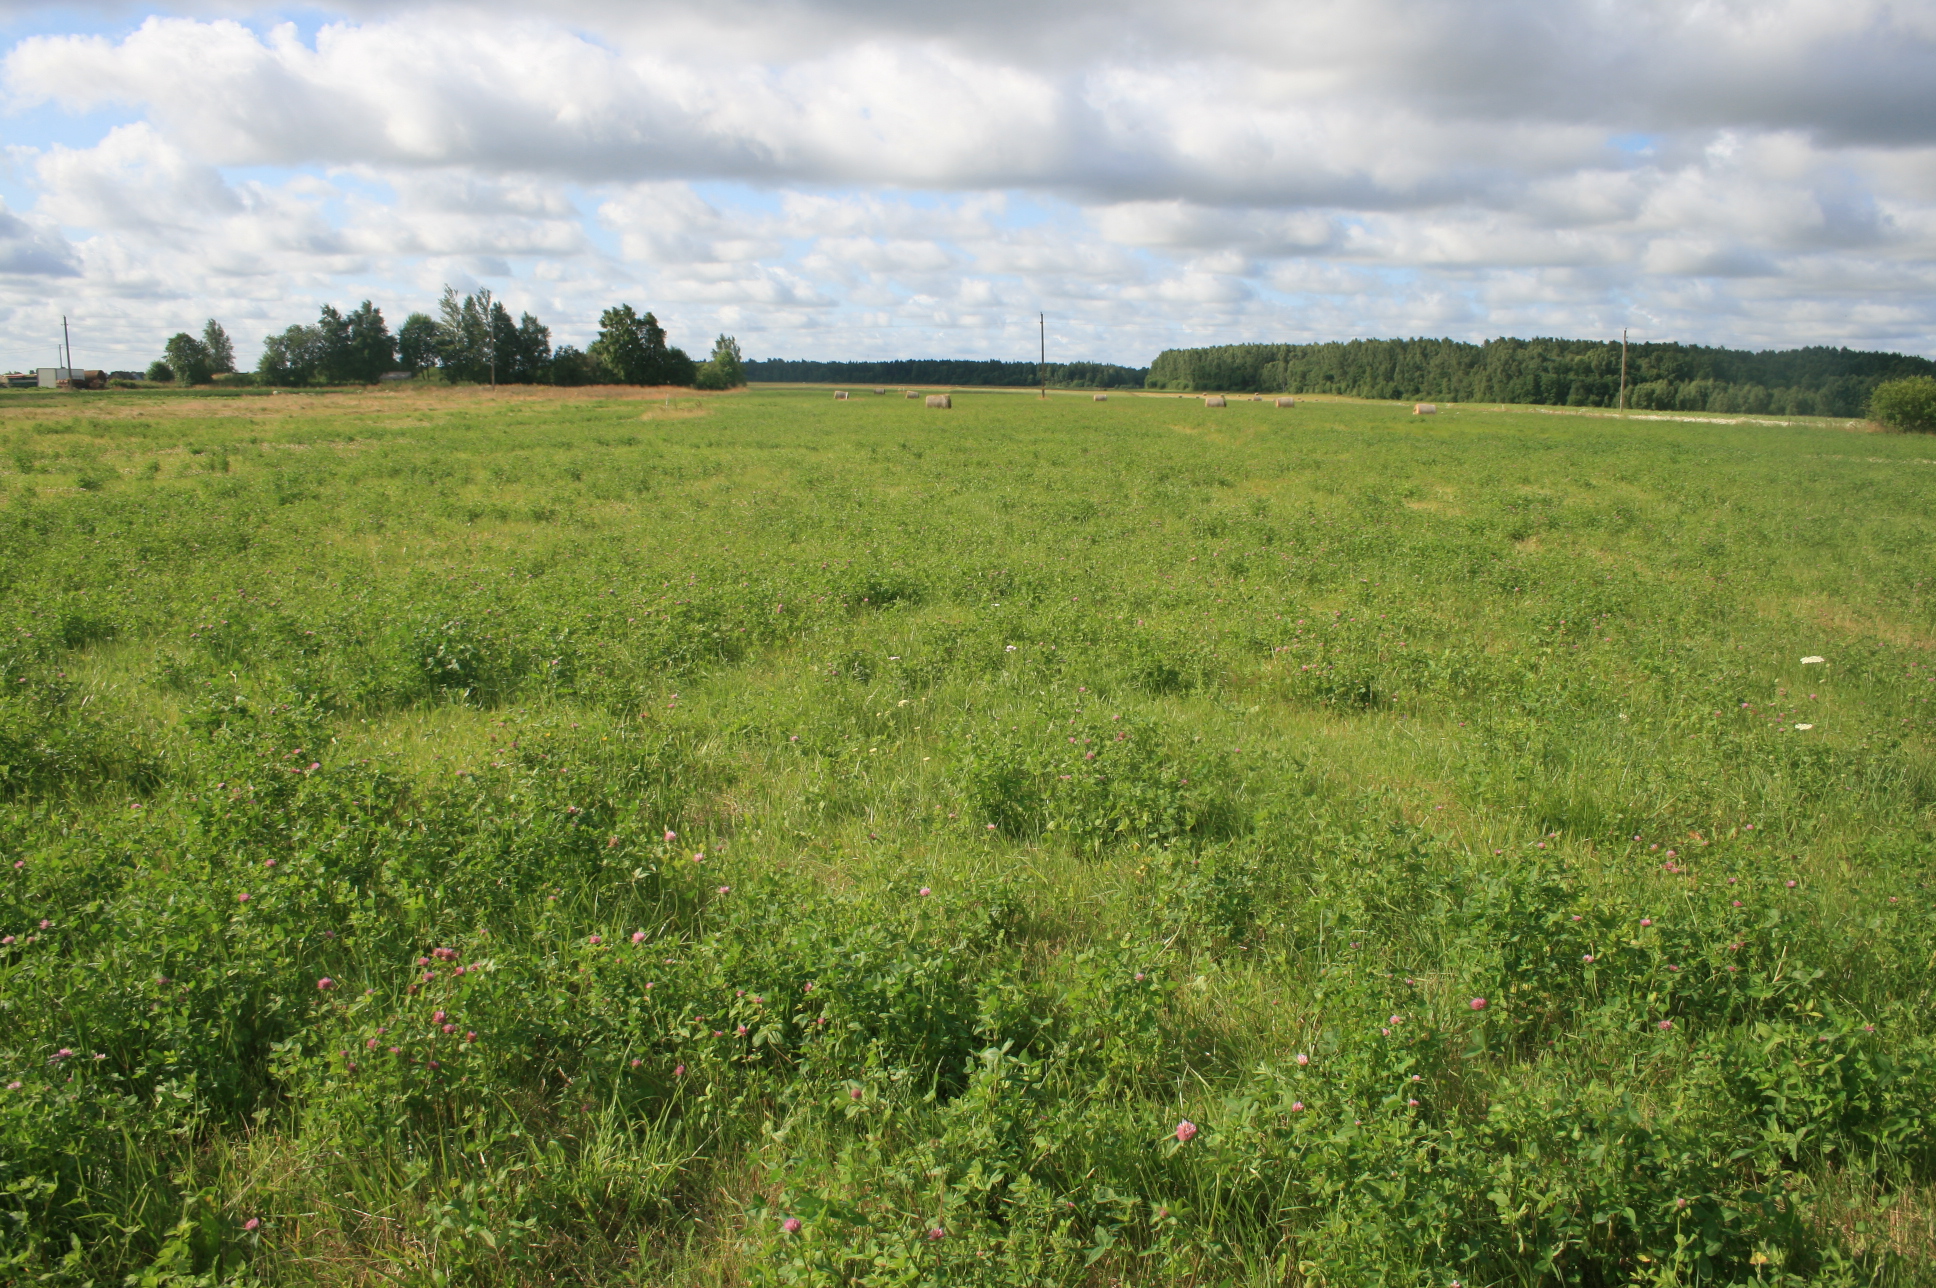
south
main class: Grassland
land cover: Grassland without tree/shrub cover
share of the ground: > 75 %
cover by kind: herbaceous plants 100 %
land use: Agriculture (excluding fallow land and kitchen gardens)
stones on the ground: < 10 %
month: July
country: LT
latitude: 55.8622
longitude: 21.3712
